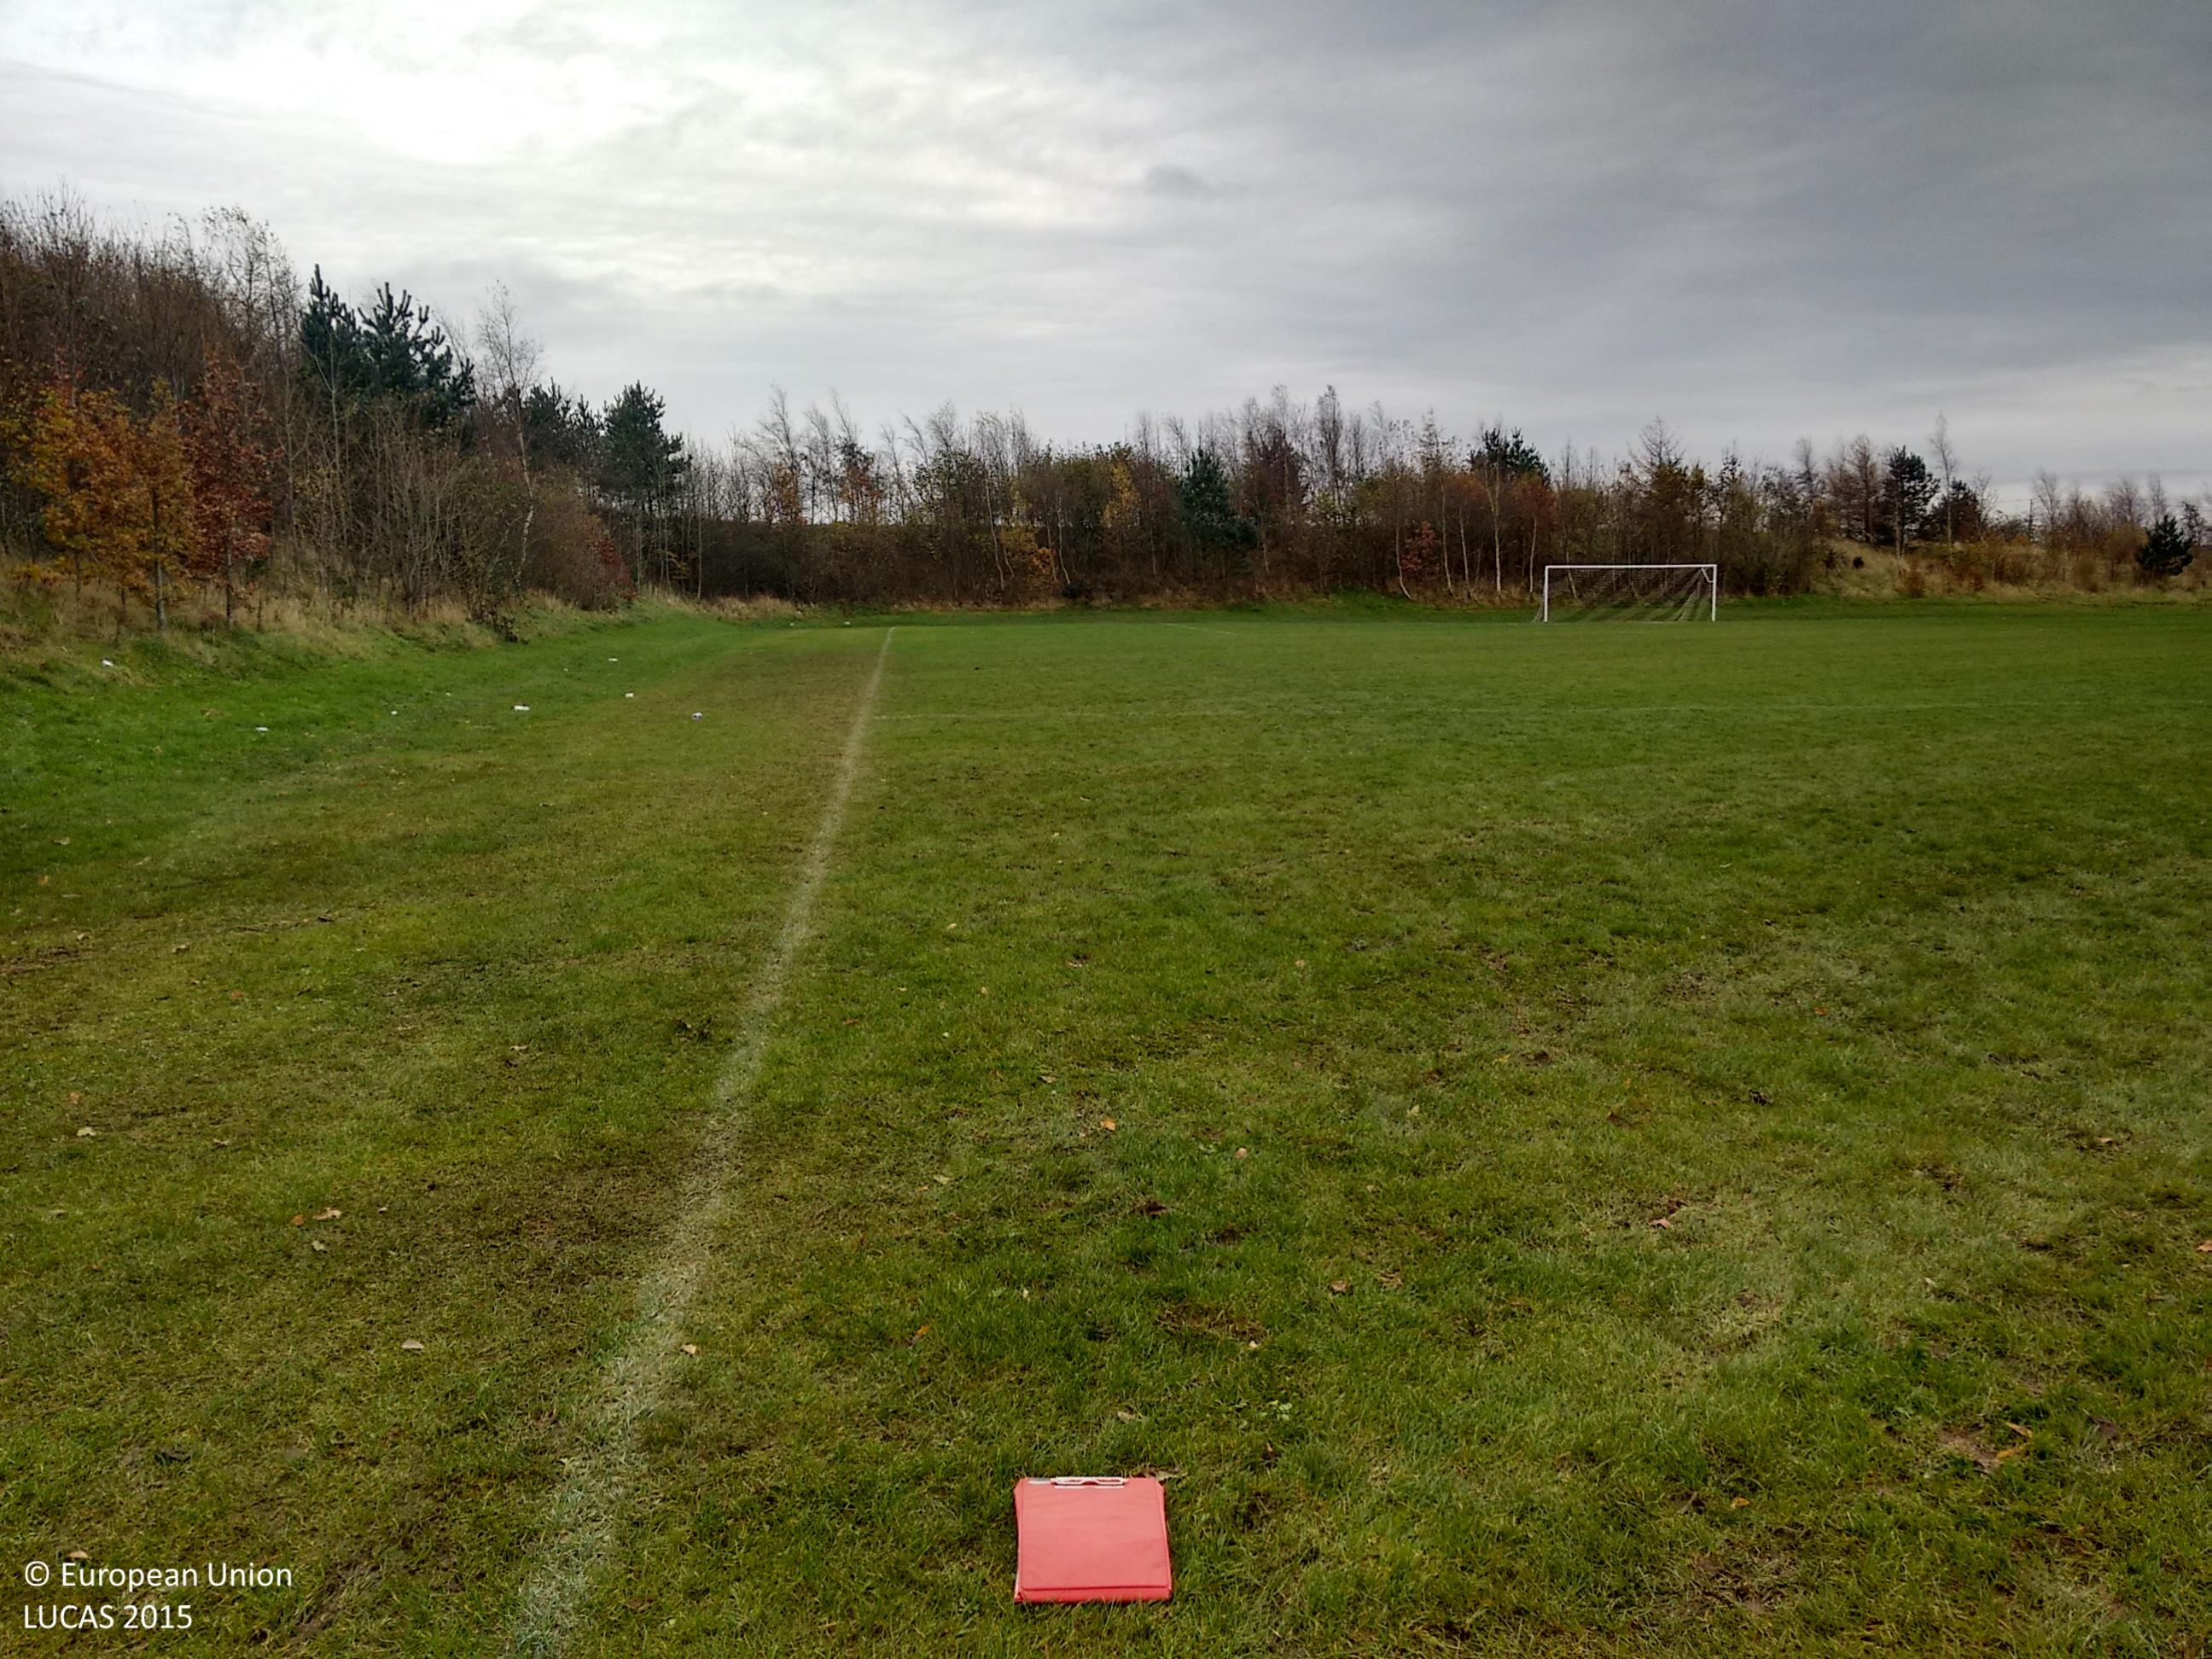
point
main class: Grassland
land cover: Grassland without tree/shrub cover
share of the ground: > 75 %
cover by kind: herbaceous plants 100 %
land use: Sport
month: November
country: GB
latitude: 54.5785
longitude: -5.7758
